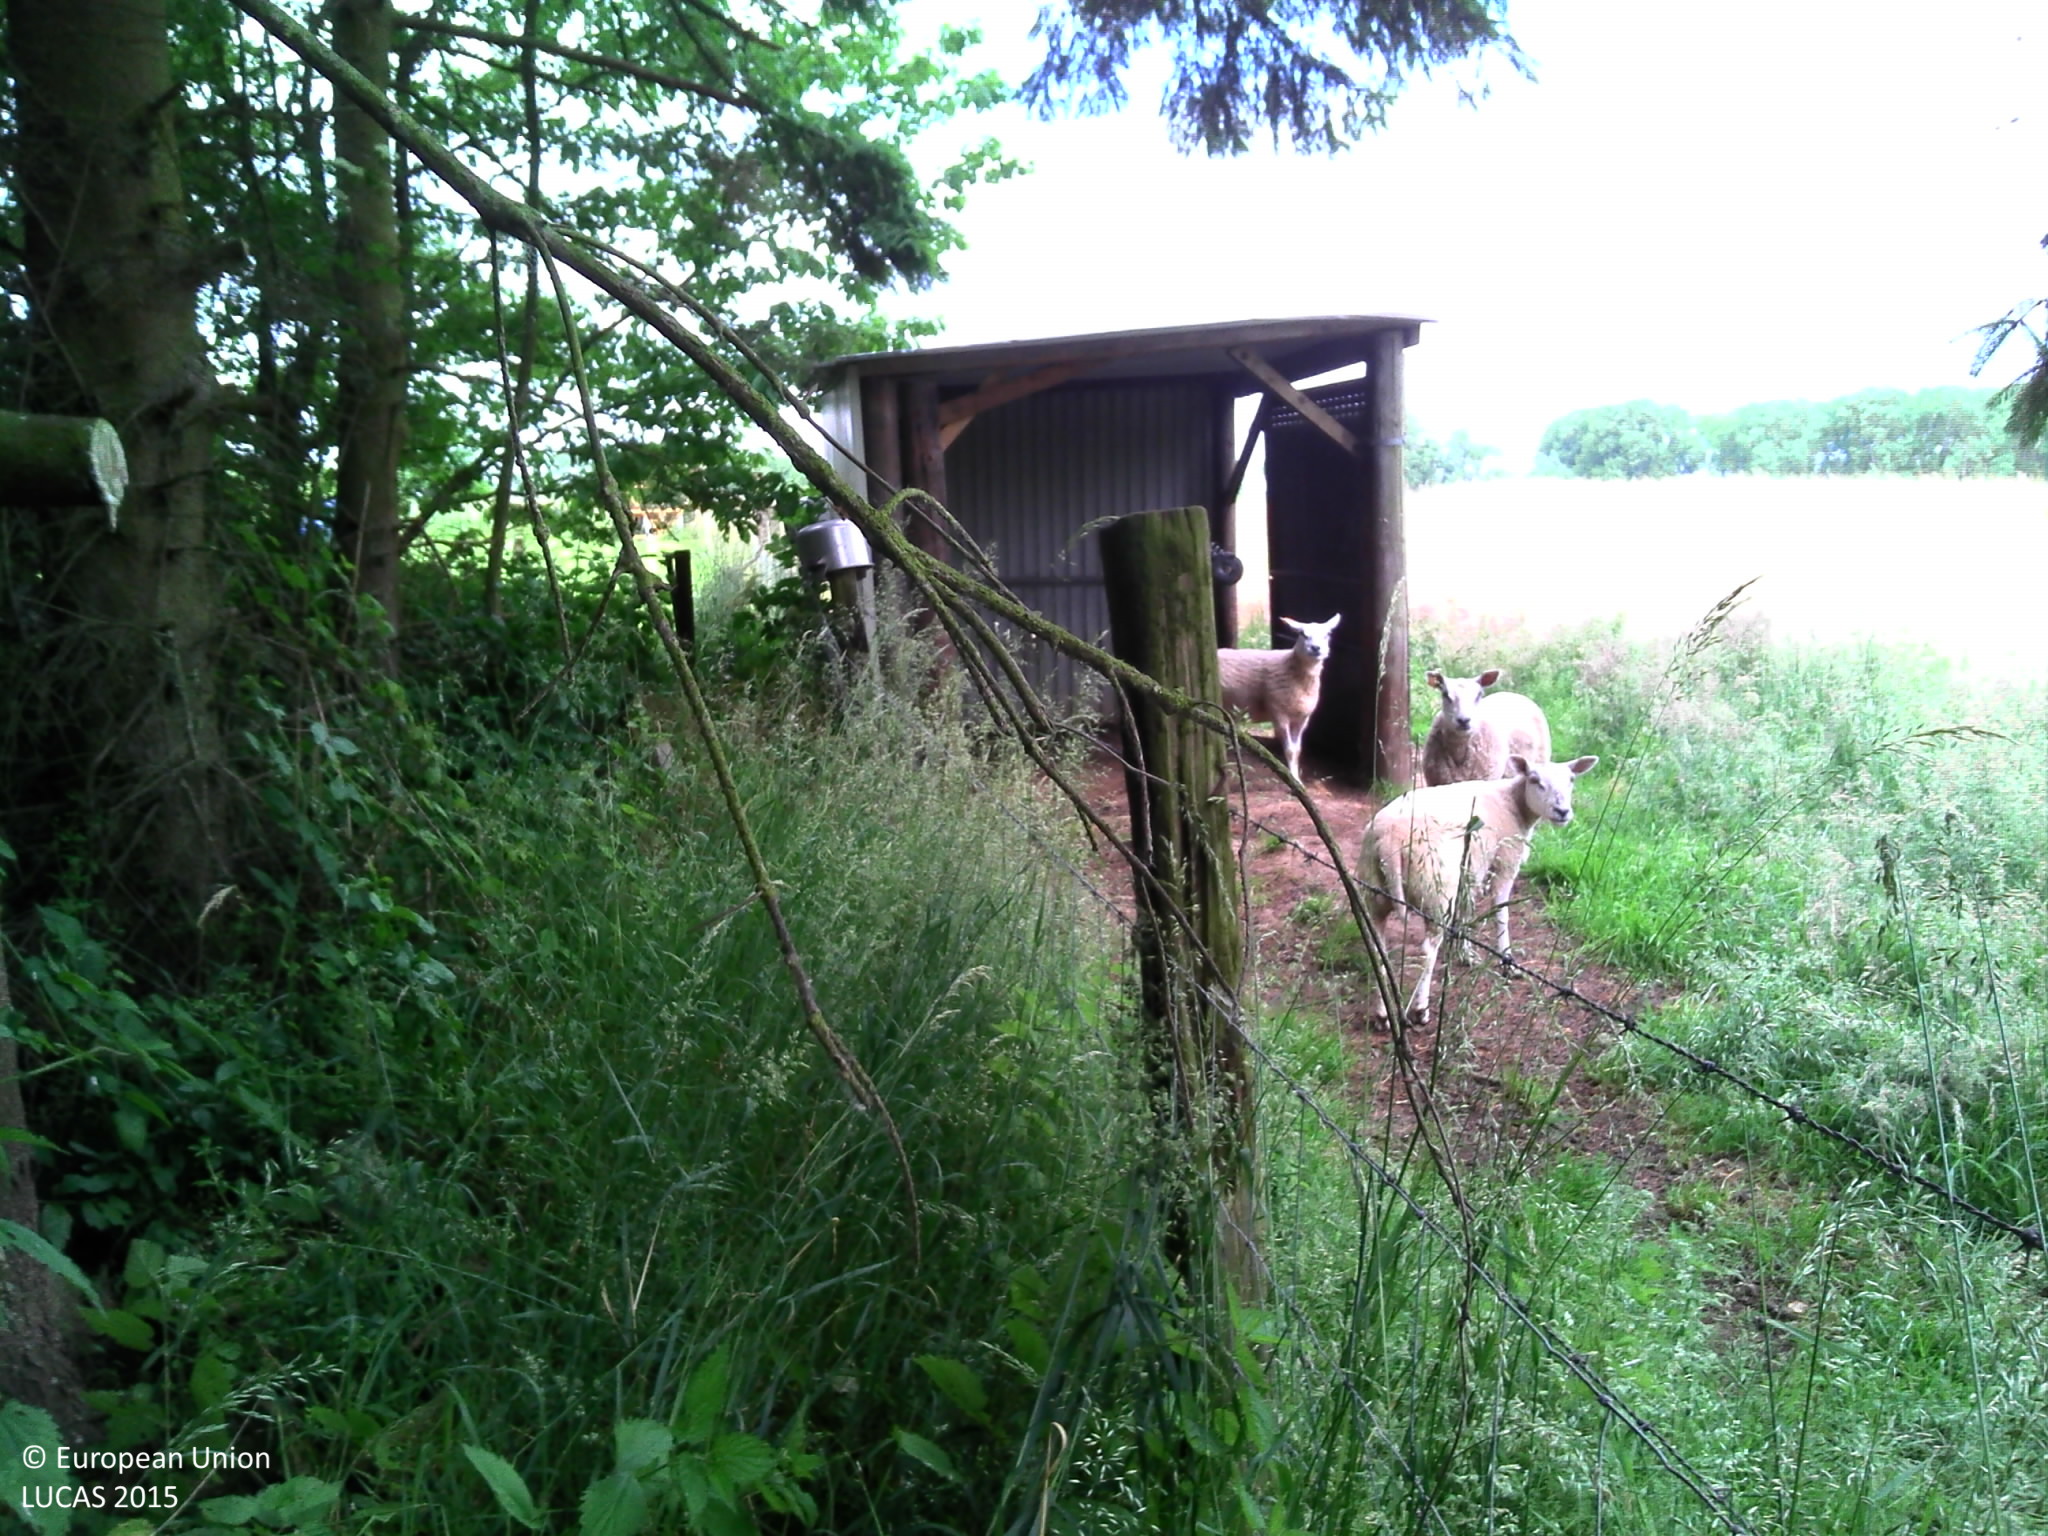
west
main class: Woodland
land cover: Spruce dominated mixed woodland
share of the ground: > 75 %
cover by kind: coniferous forest trees 40 %, broadleaved forest trees 35 %, herbaceous plants 25 %
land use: Forestry
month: June
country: BE
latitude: 50.9338
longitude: 4.1178
